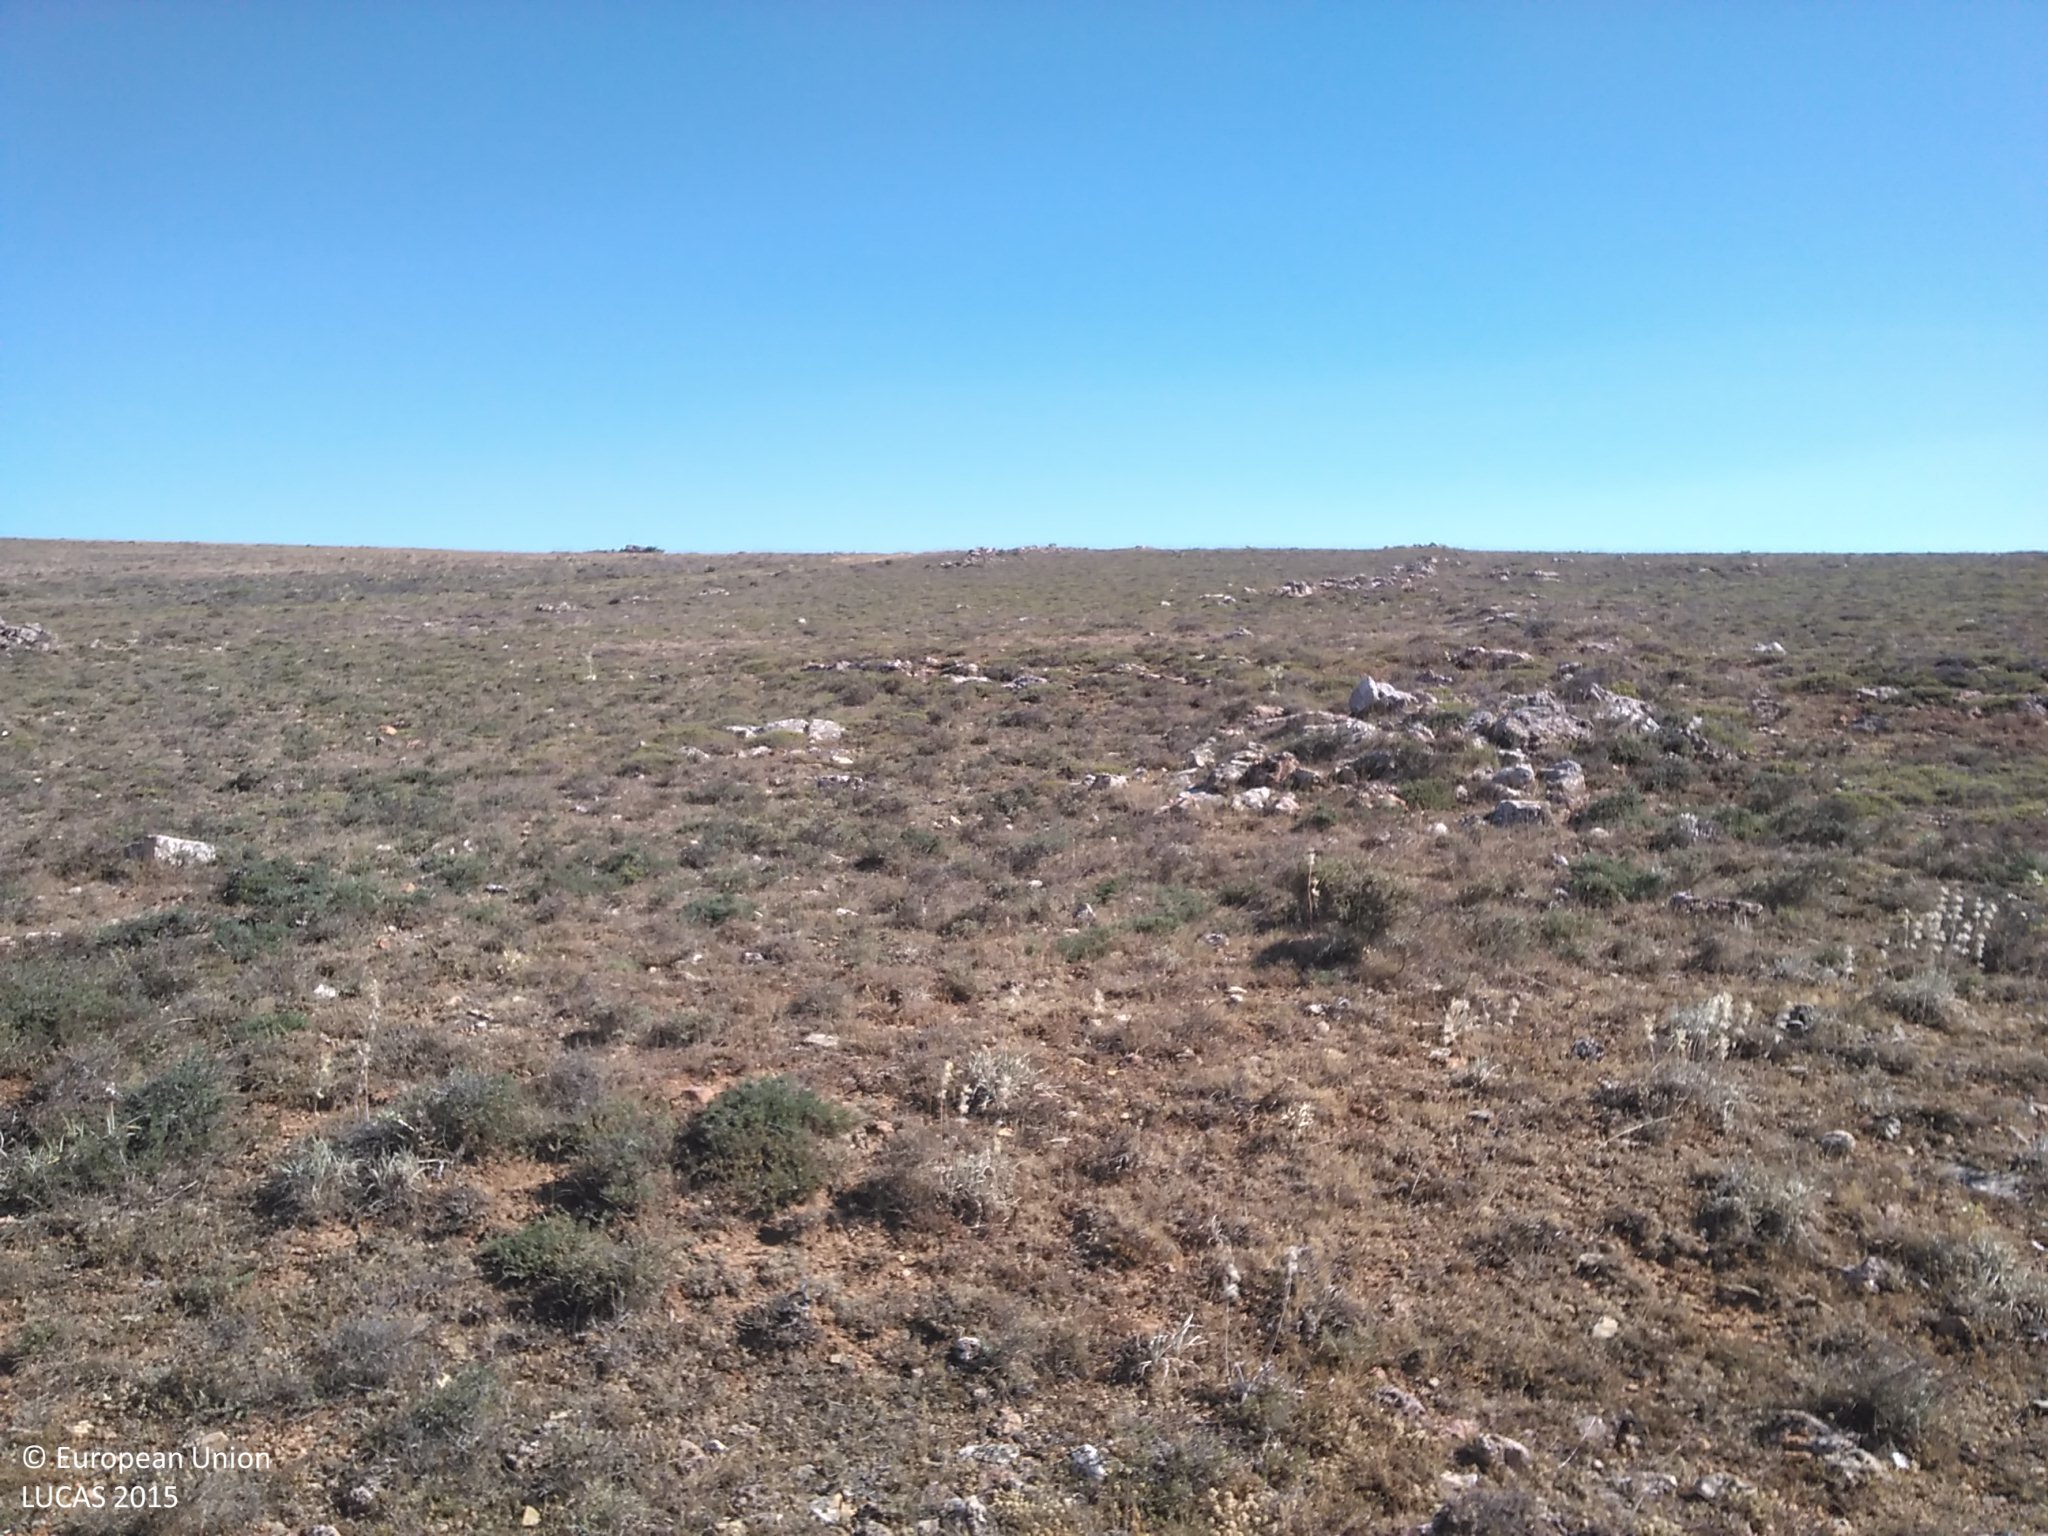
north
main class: Shrubland
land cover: Shrubland without tree cover
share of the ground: 50 - 75 %
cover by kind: shrubs 60 %, unconsolidated bare surface 40 %
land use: Semi-natural and natural areas not in use
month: July
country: ES
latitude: 41.2893
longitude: -2.9465
